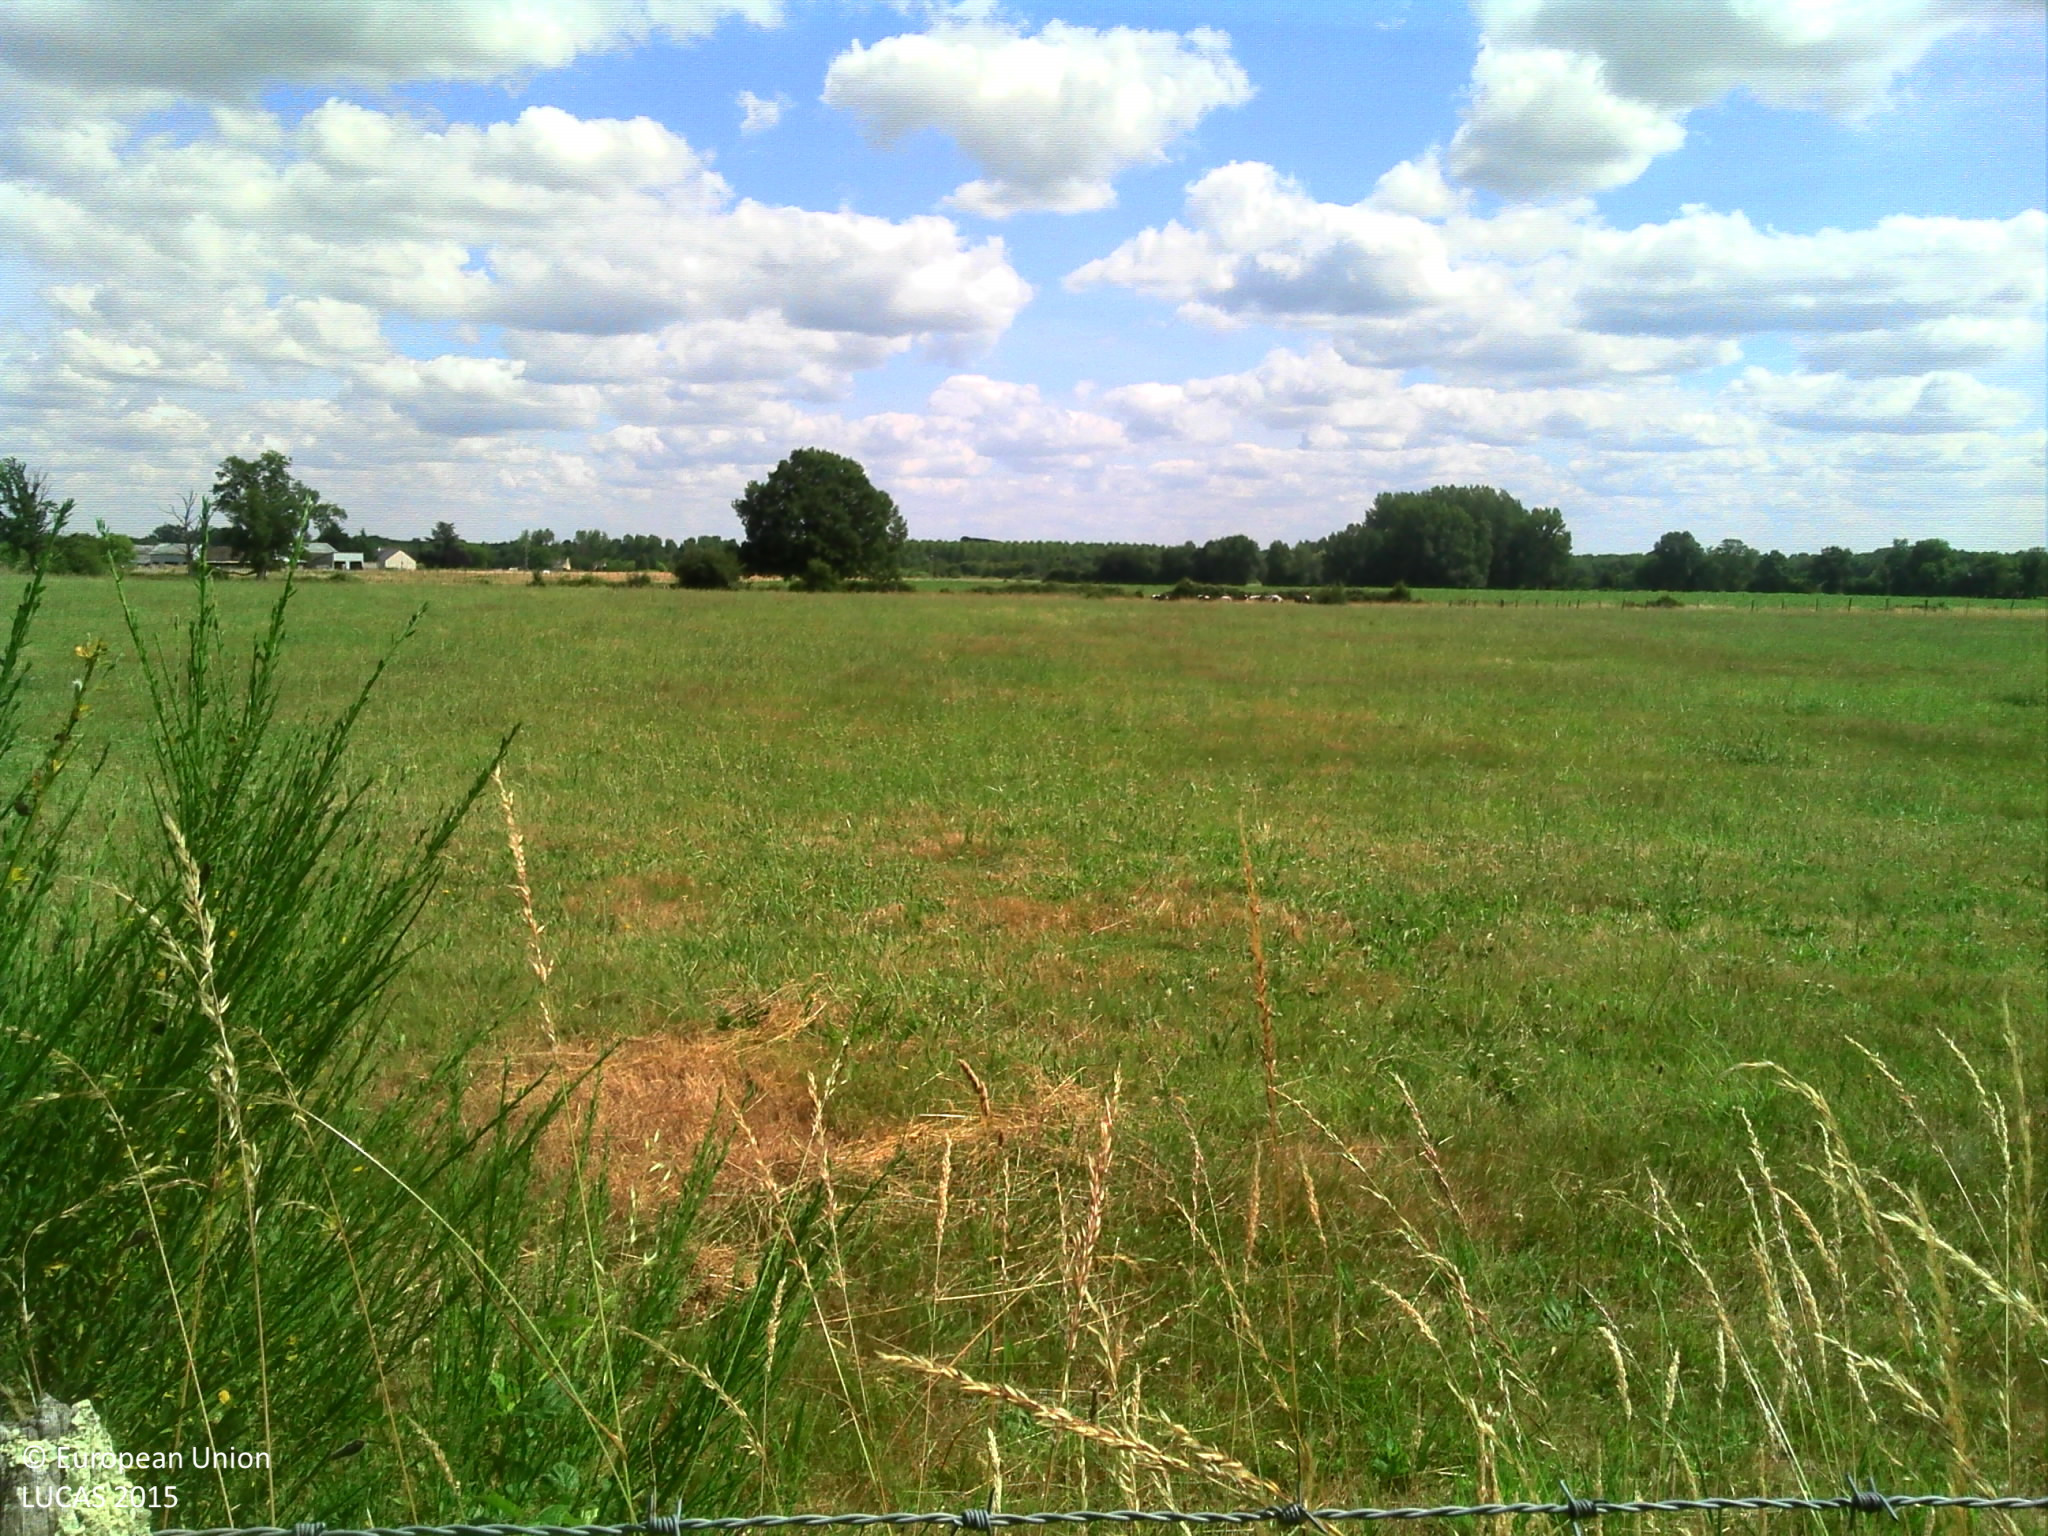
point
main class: Grassland
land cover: Grassland without tree/shrub cover
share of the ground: > 75 %
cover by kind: herbaceous plants 100 %
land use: Agriculture (excluding fallow land and kitchen gardens)
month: June
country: FR
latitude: 47.4714
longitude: 0.3313
